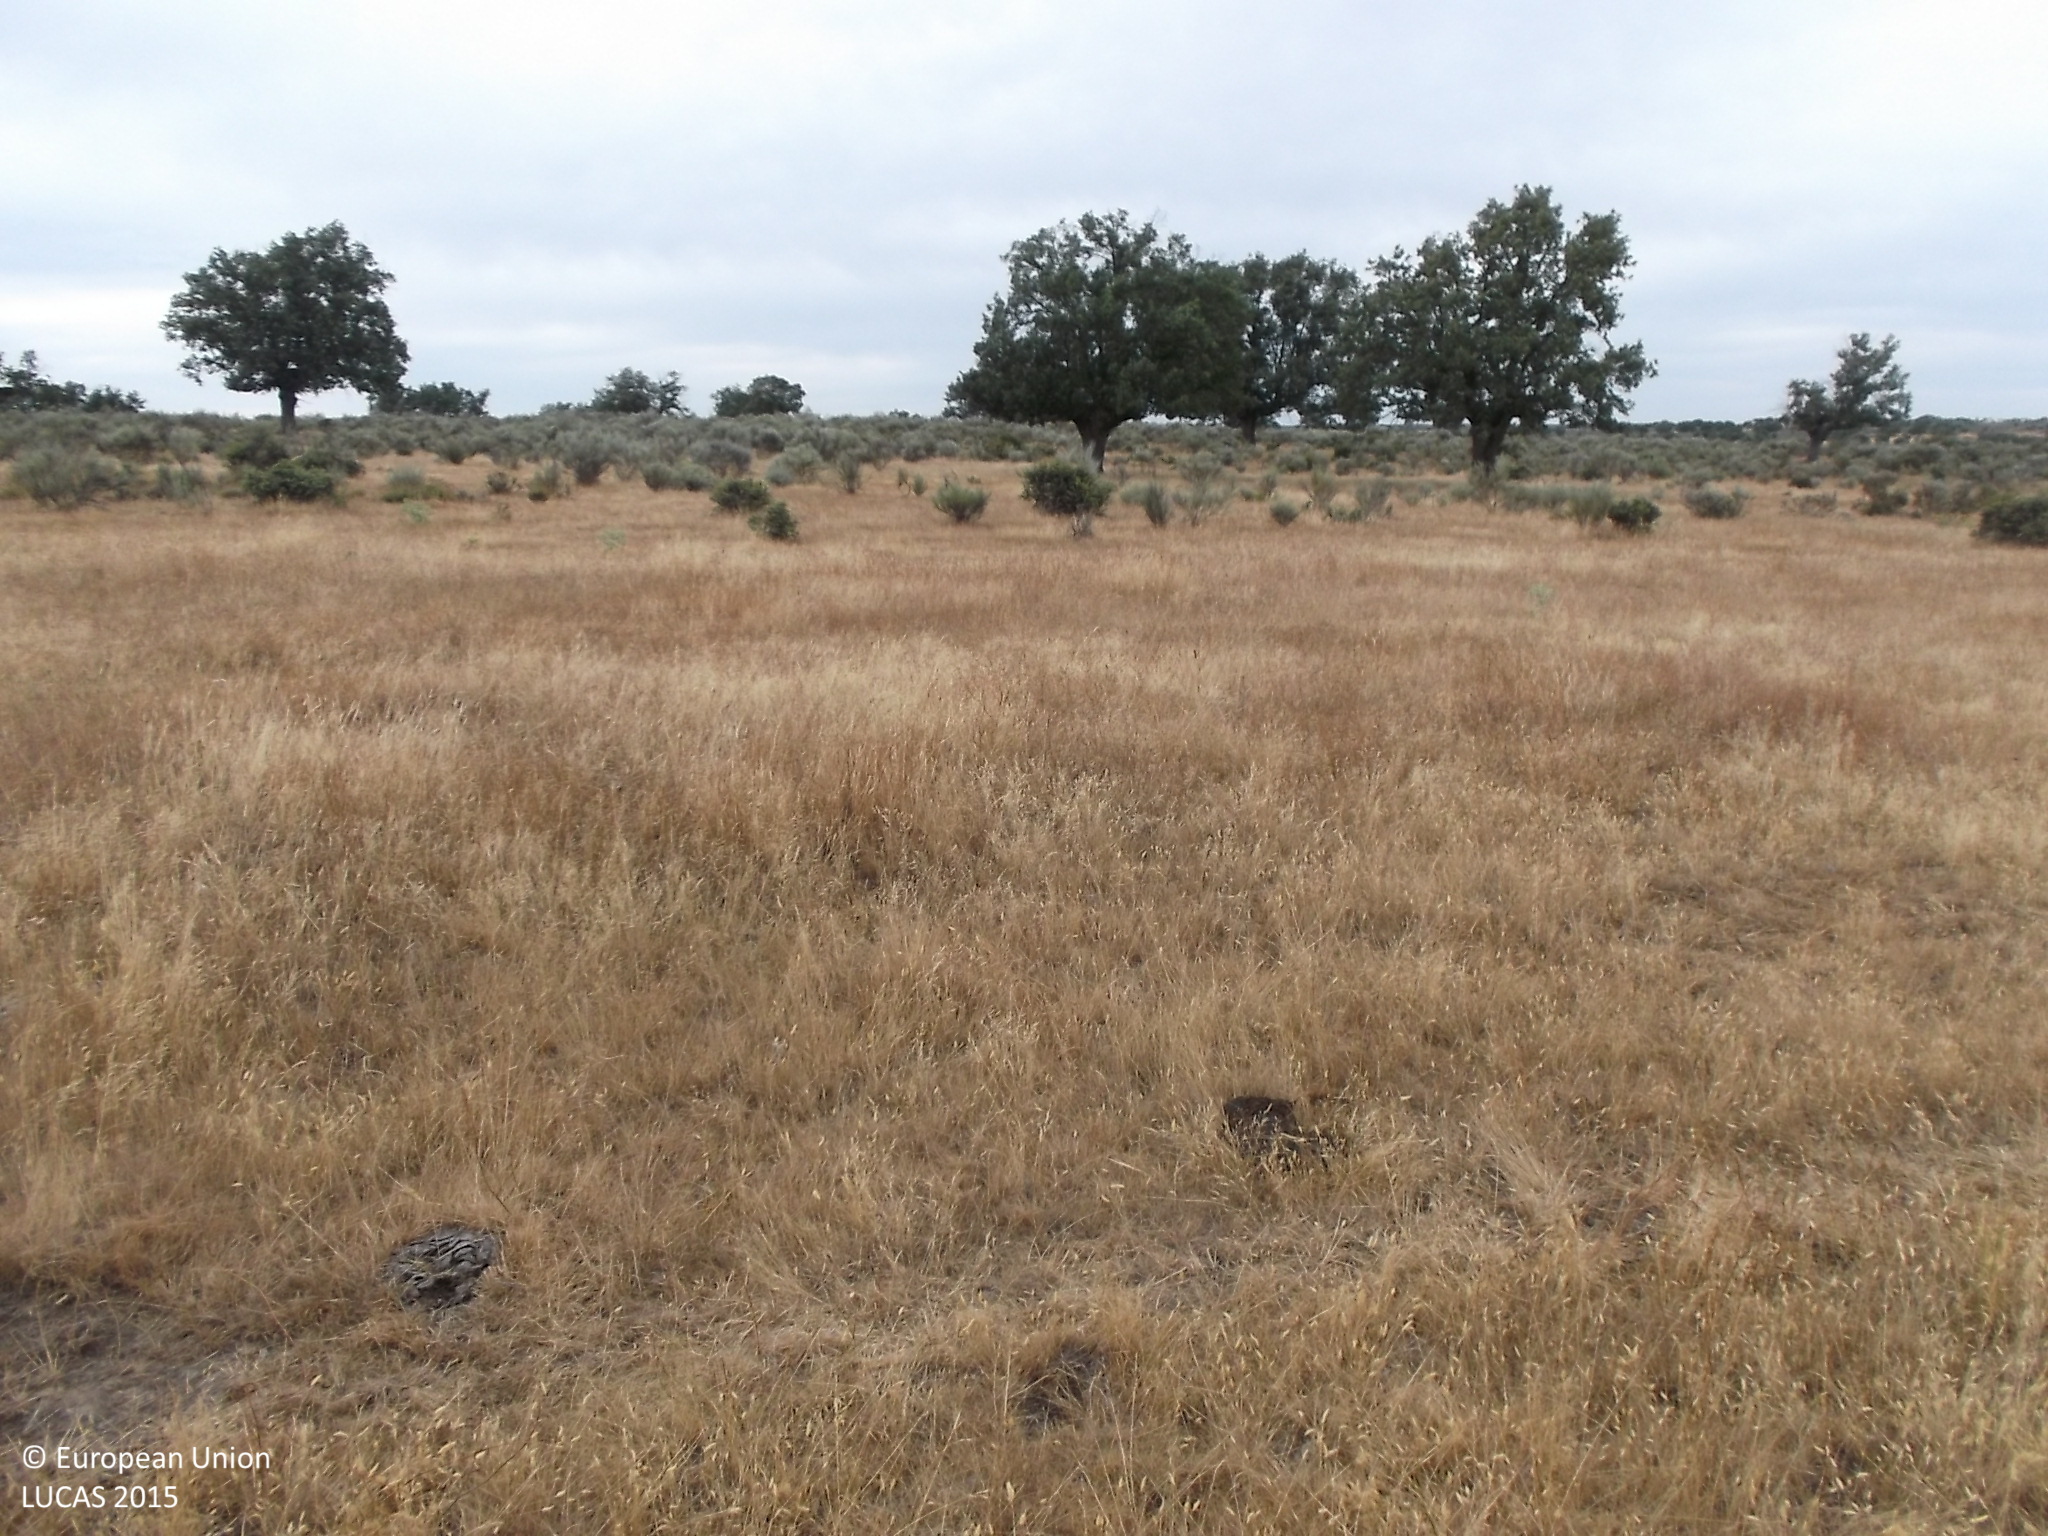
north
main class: Grassland
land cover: Grassland without tree/shrub cover
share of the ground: > 75 %
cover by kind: herbaceous plants 100 %
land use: Agriculture (excluding fallow land and kitchen gardens)
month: July
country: ES
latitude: 41.0619
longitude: -6.4329
